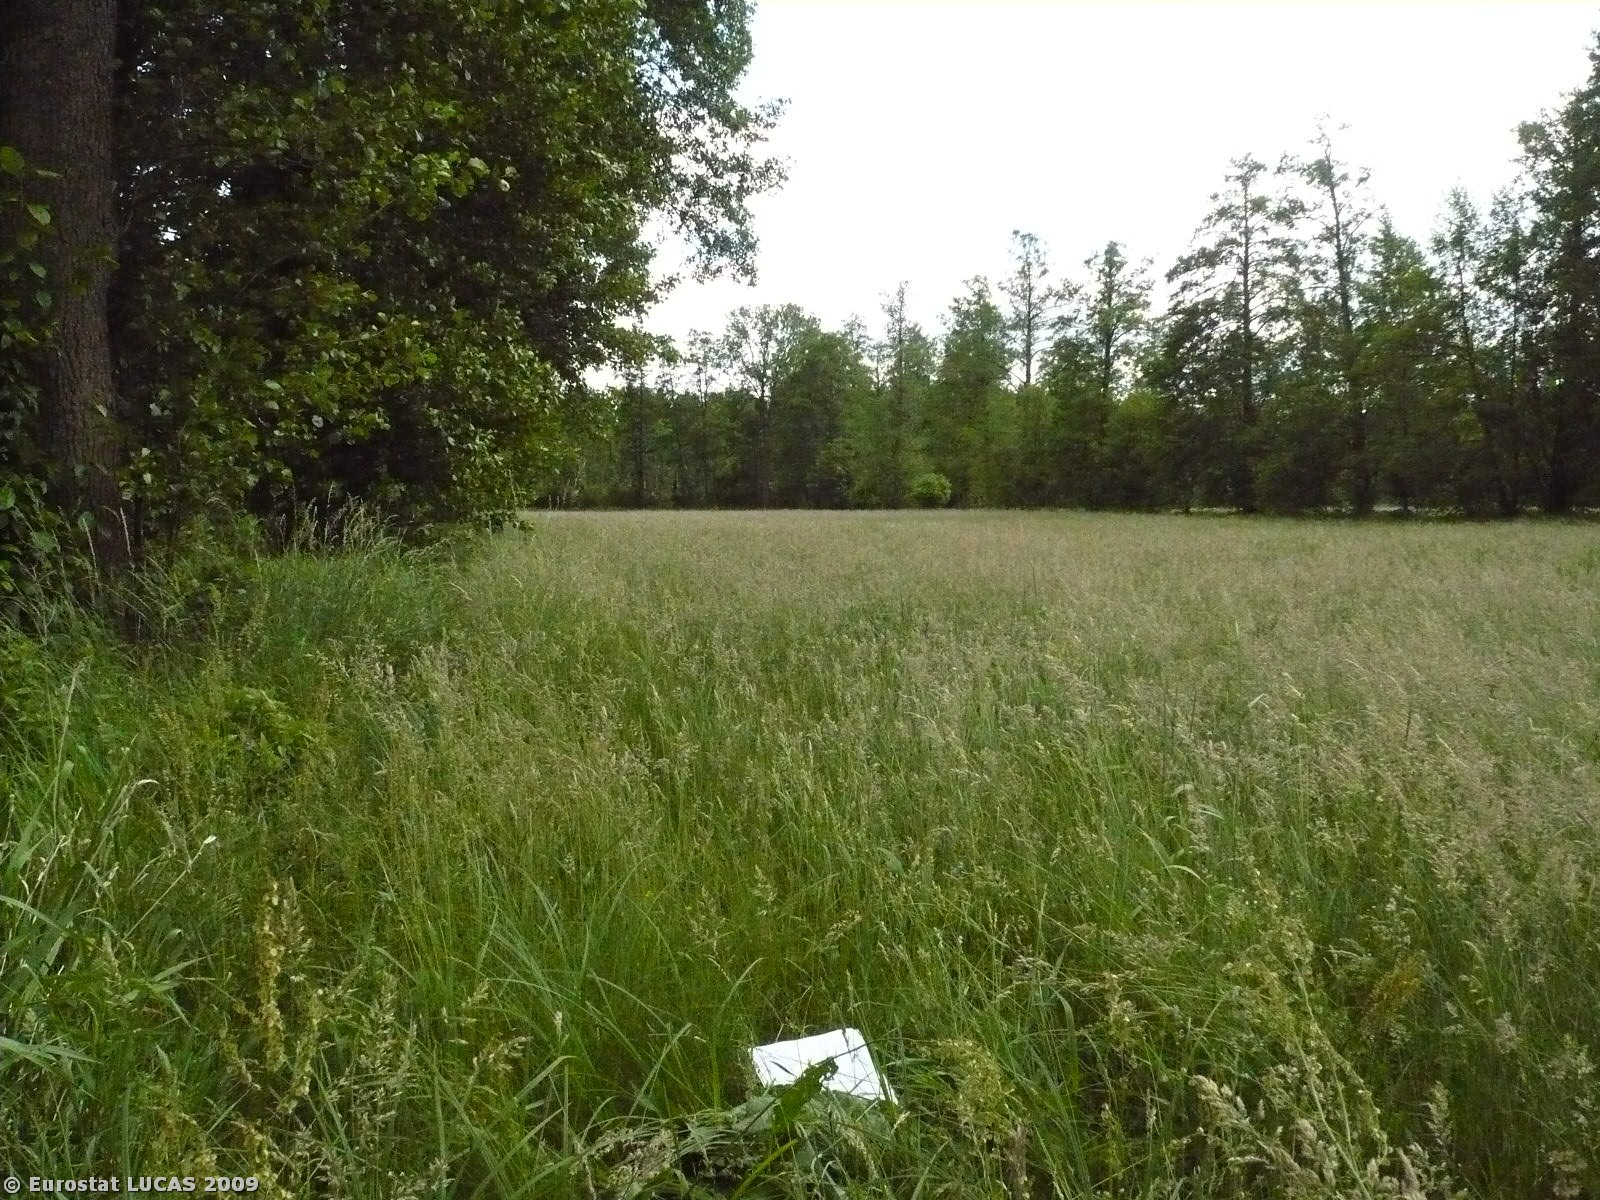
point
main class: Grassland
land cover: Grassland without tree/shrub cover
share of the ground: > 75 %
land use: Agriculture (excluding fallow land and kitchen gardens)
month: May
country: PL
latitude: 52.1005
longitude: 16.3281
